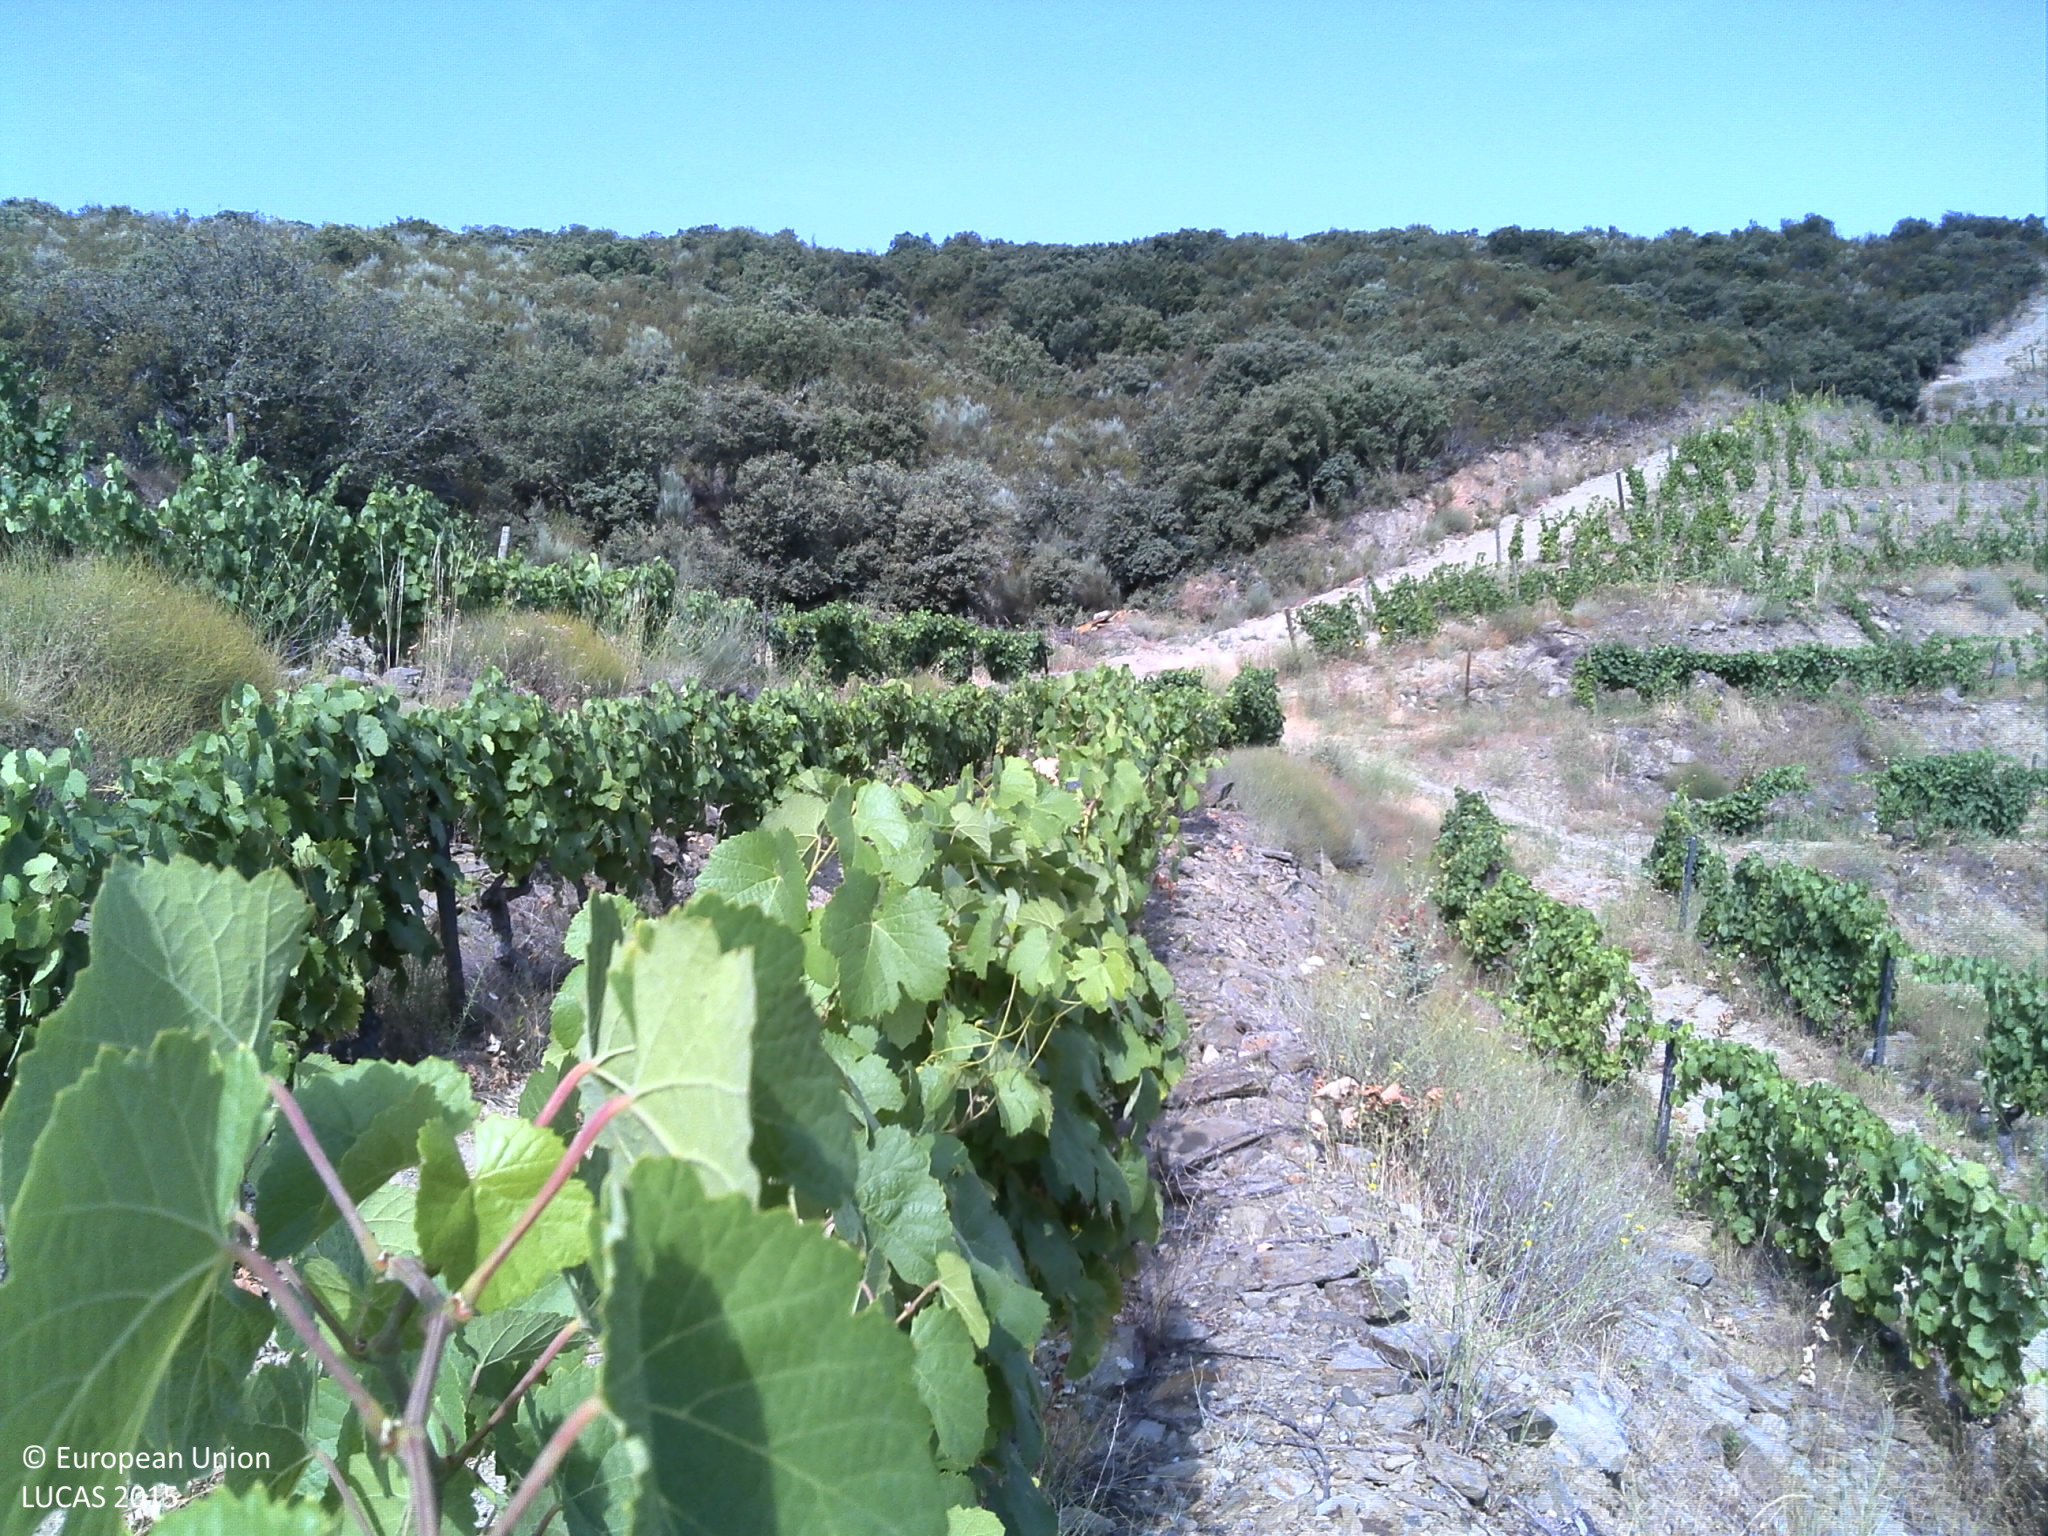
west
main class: Cropland
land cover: Vineyards
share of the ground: < 10 %
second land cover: Other bare soil
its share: > 75 %
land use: Agriculture (excluding fallow land and kitchen gardens)
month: July
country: PT
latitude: 41.0406
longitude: -7.3044
